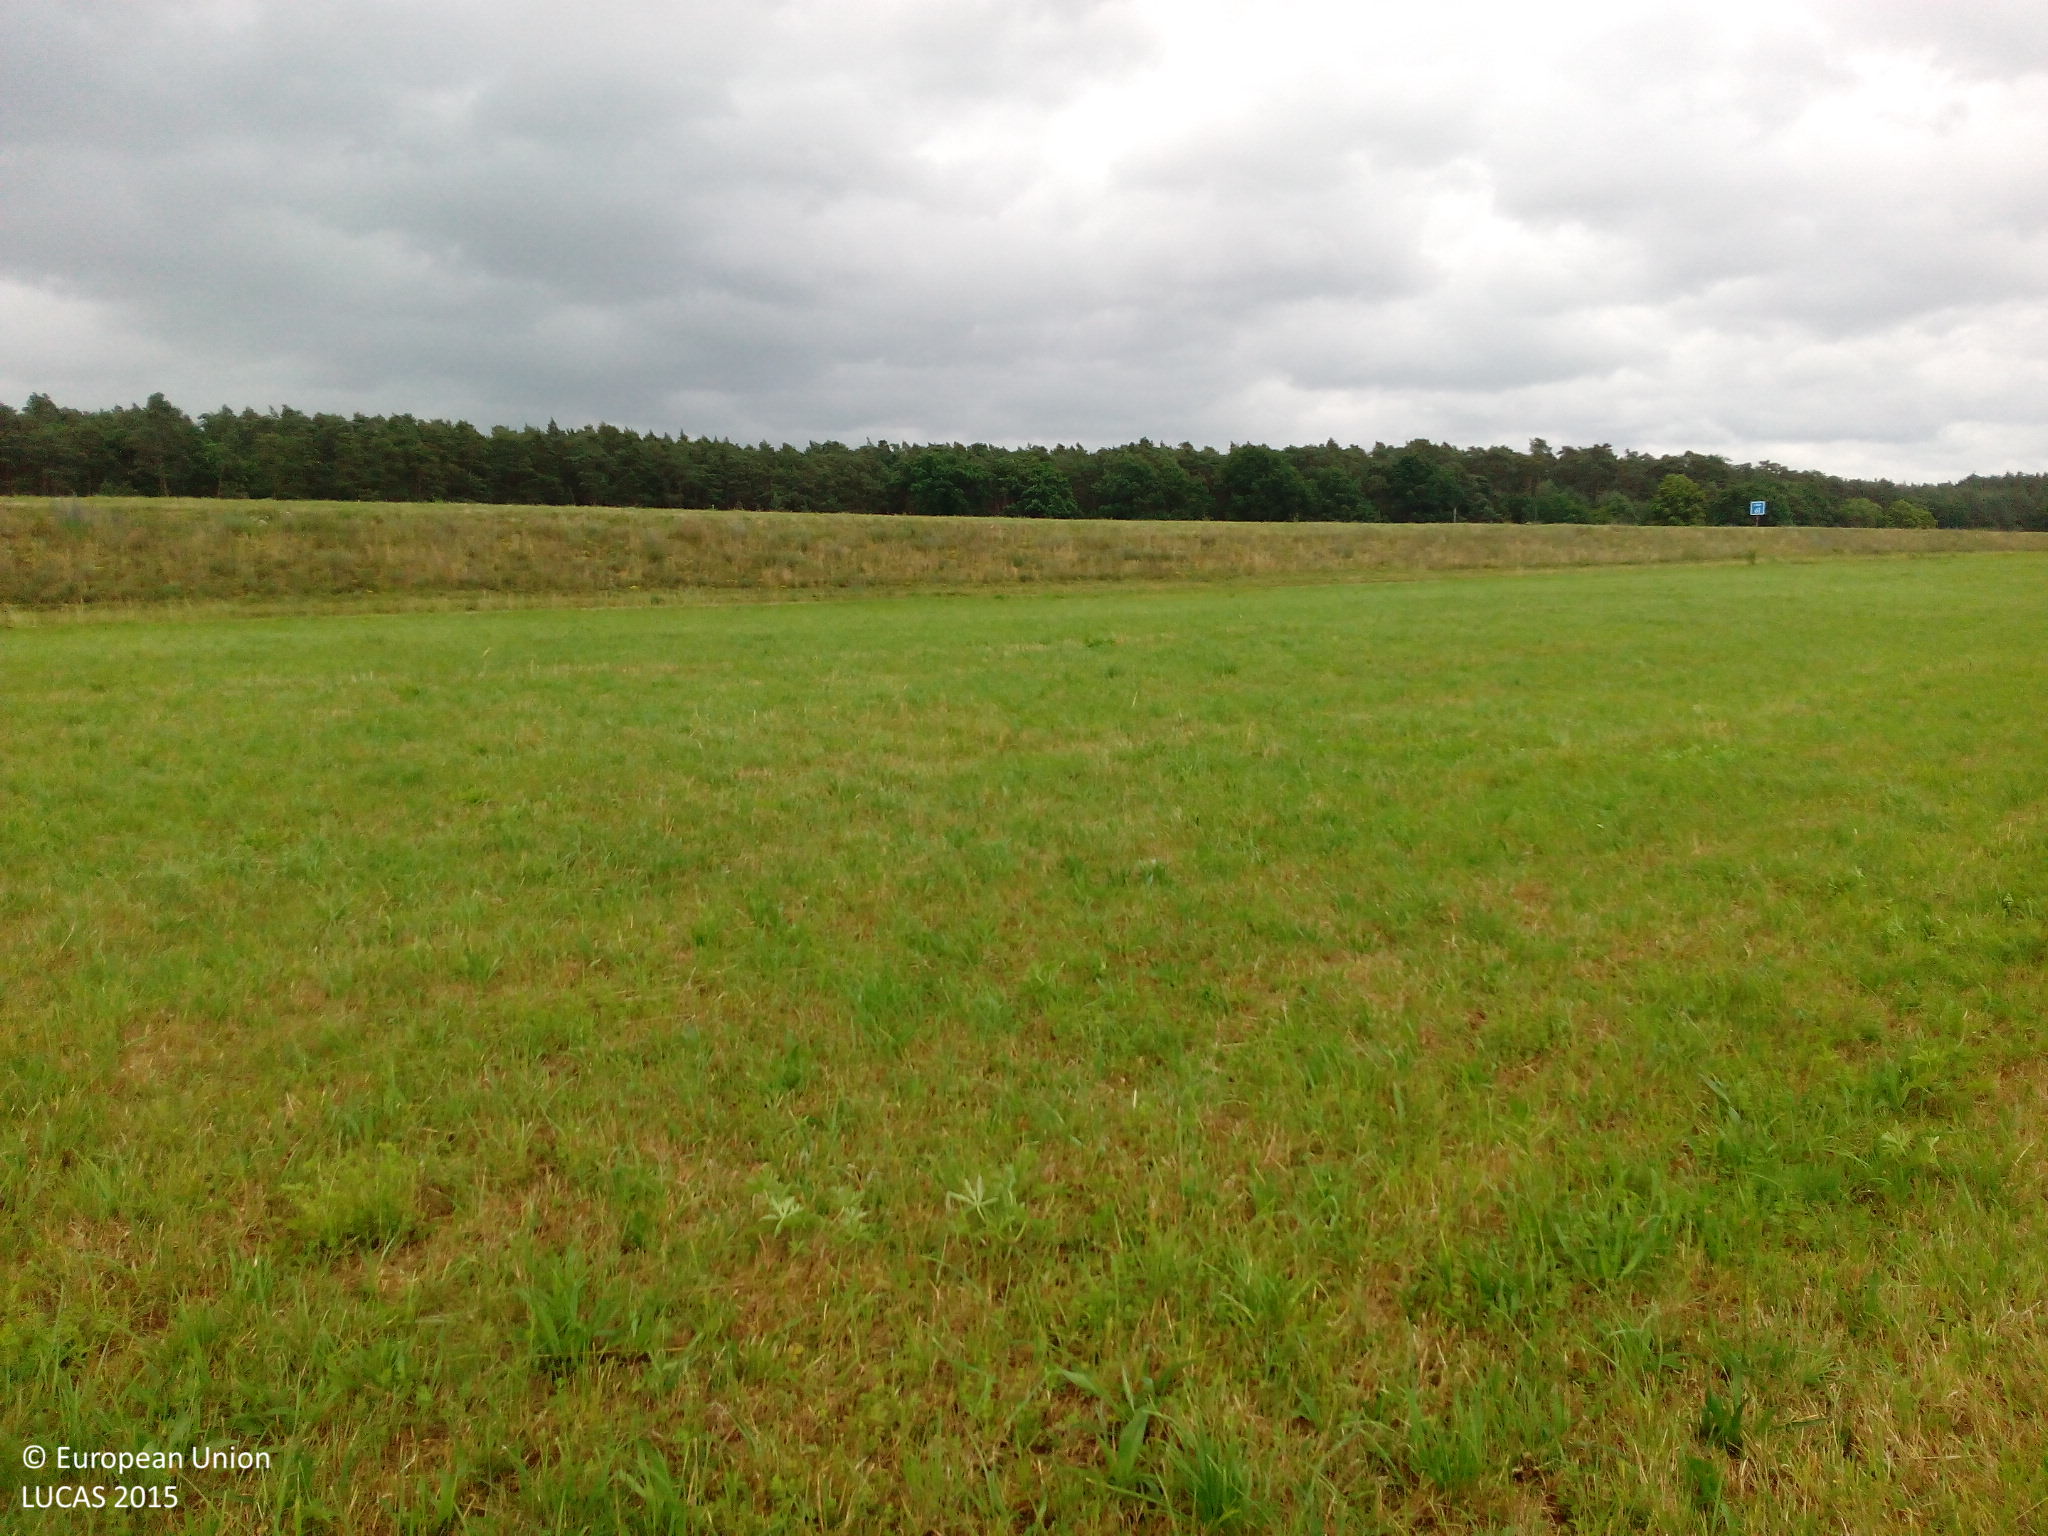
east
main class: Grassland
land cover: Grassland without tree/shrub cover
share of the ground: > 75 %
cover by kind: herbaceous plants 100 %
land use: Agriculture (excluding fallow land and kitchen gardens)
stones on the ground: < 10 %
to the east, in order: Grassland without tree/shrub cover; Artificial constructions in urban areas; Grassland without tree/shrub cover; Inland fresh running water; Artificial constructions; Grassland without tree/shrub cover; Artificial constructions in urban areas; Grass margins; Sugar beet
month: June
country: DE
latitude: 49.8567
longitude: 10.9316
